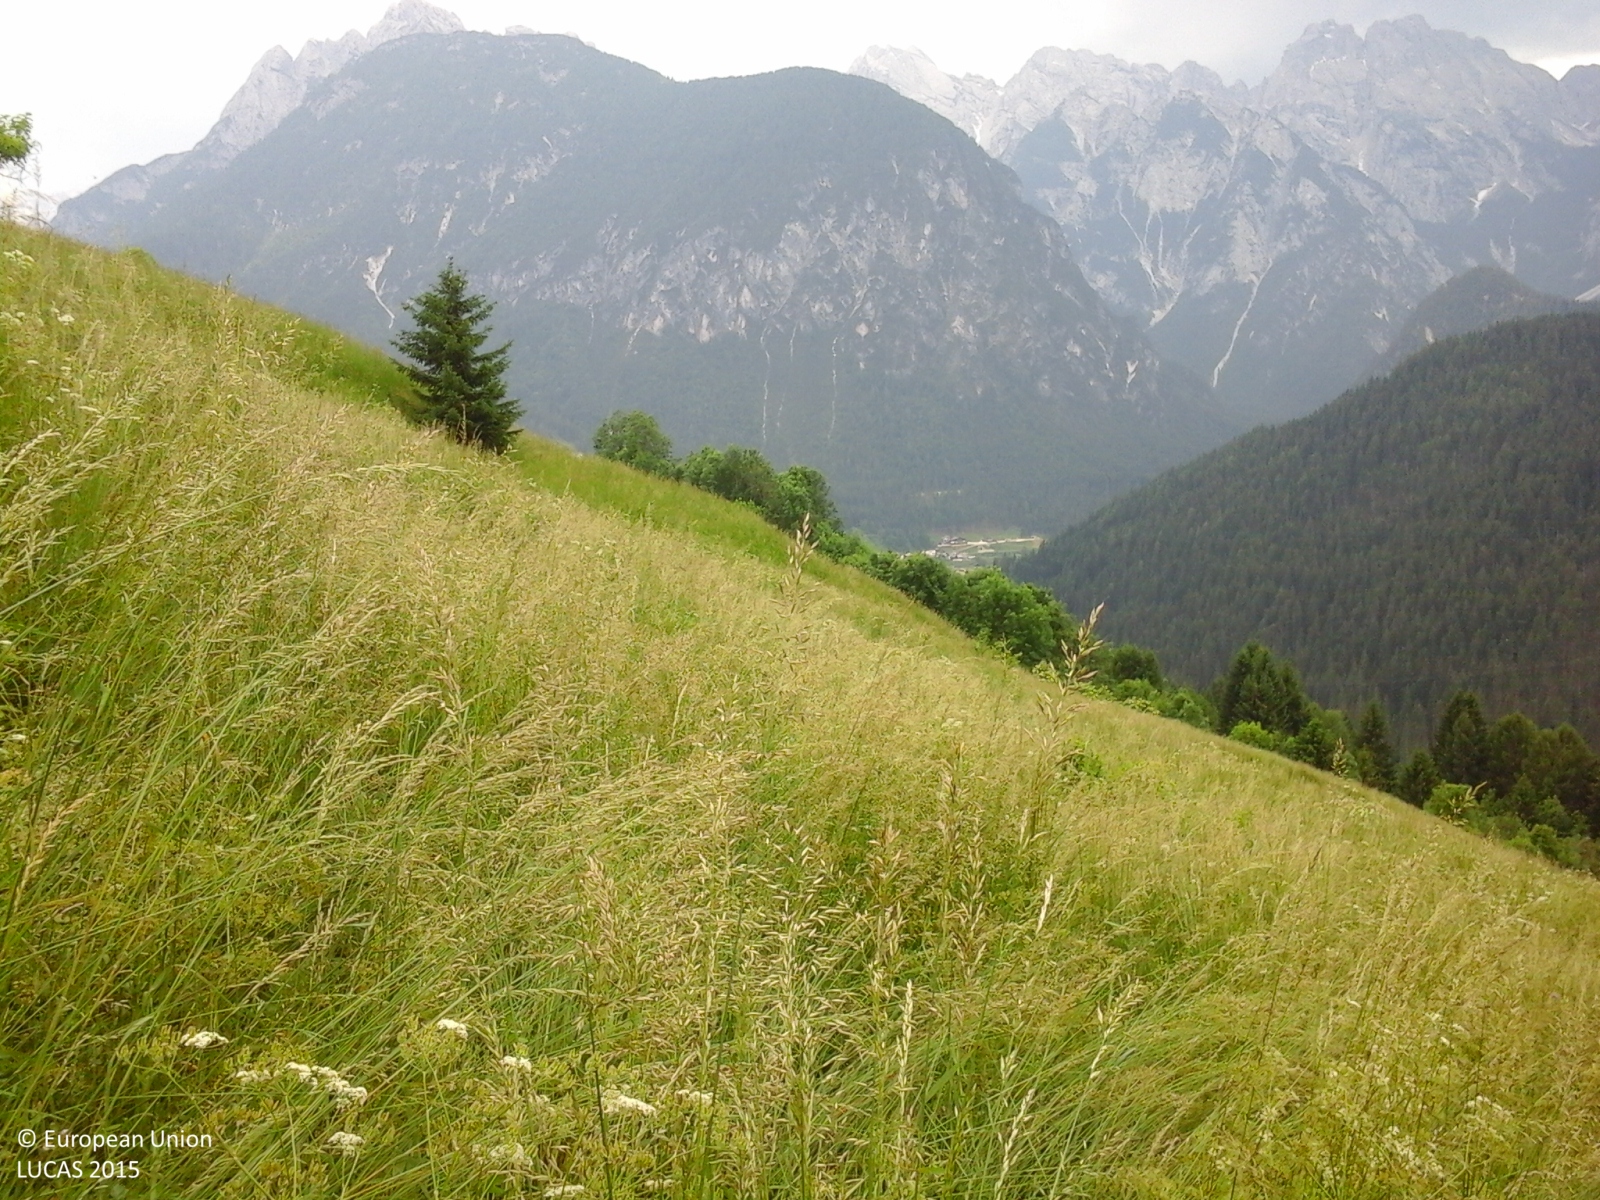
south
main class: Grassland
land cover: Grassland without tree/shrub cover
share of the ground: > 75 %
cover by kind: herbaceous plants 100 %
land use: Agriculture (excluding fallow land and kitchen gardens)
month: June
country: IT
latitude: 46.5733
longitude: 12.5417
